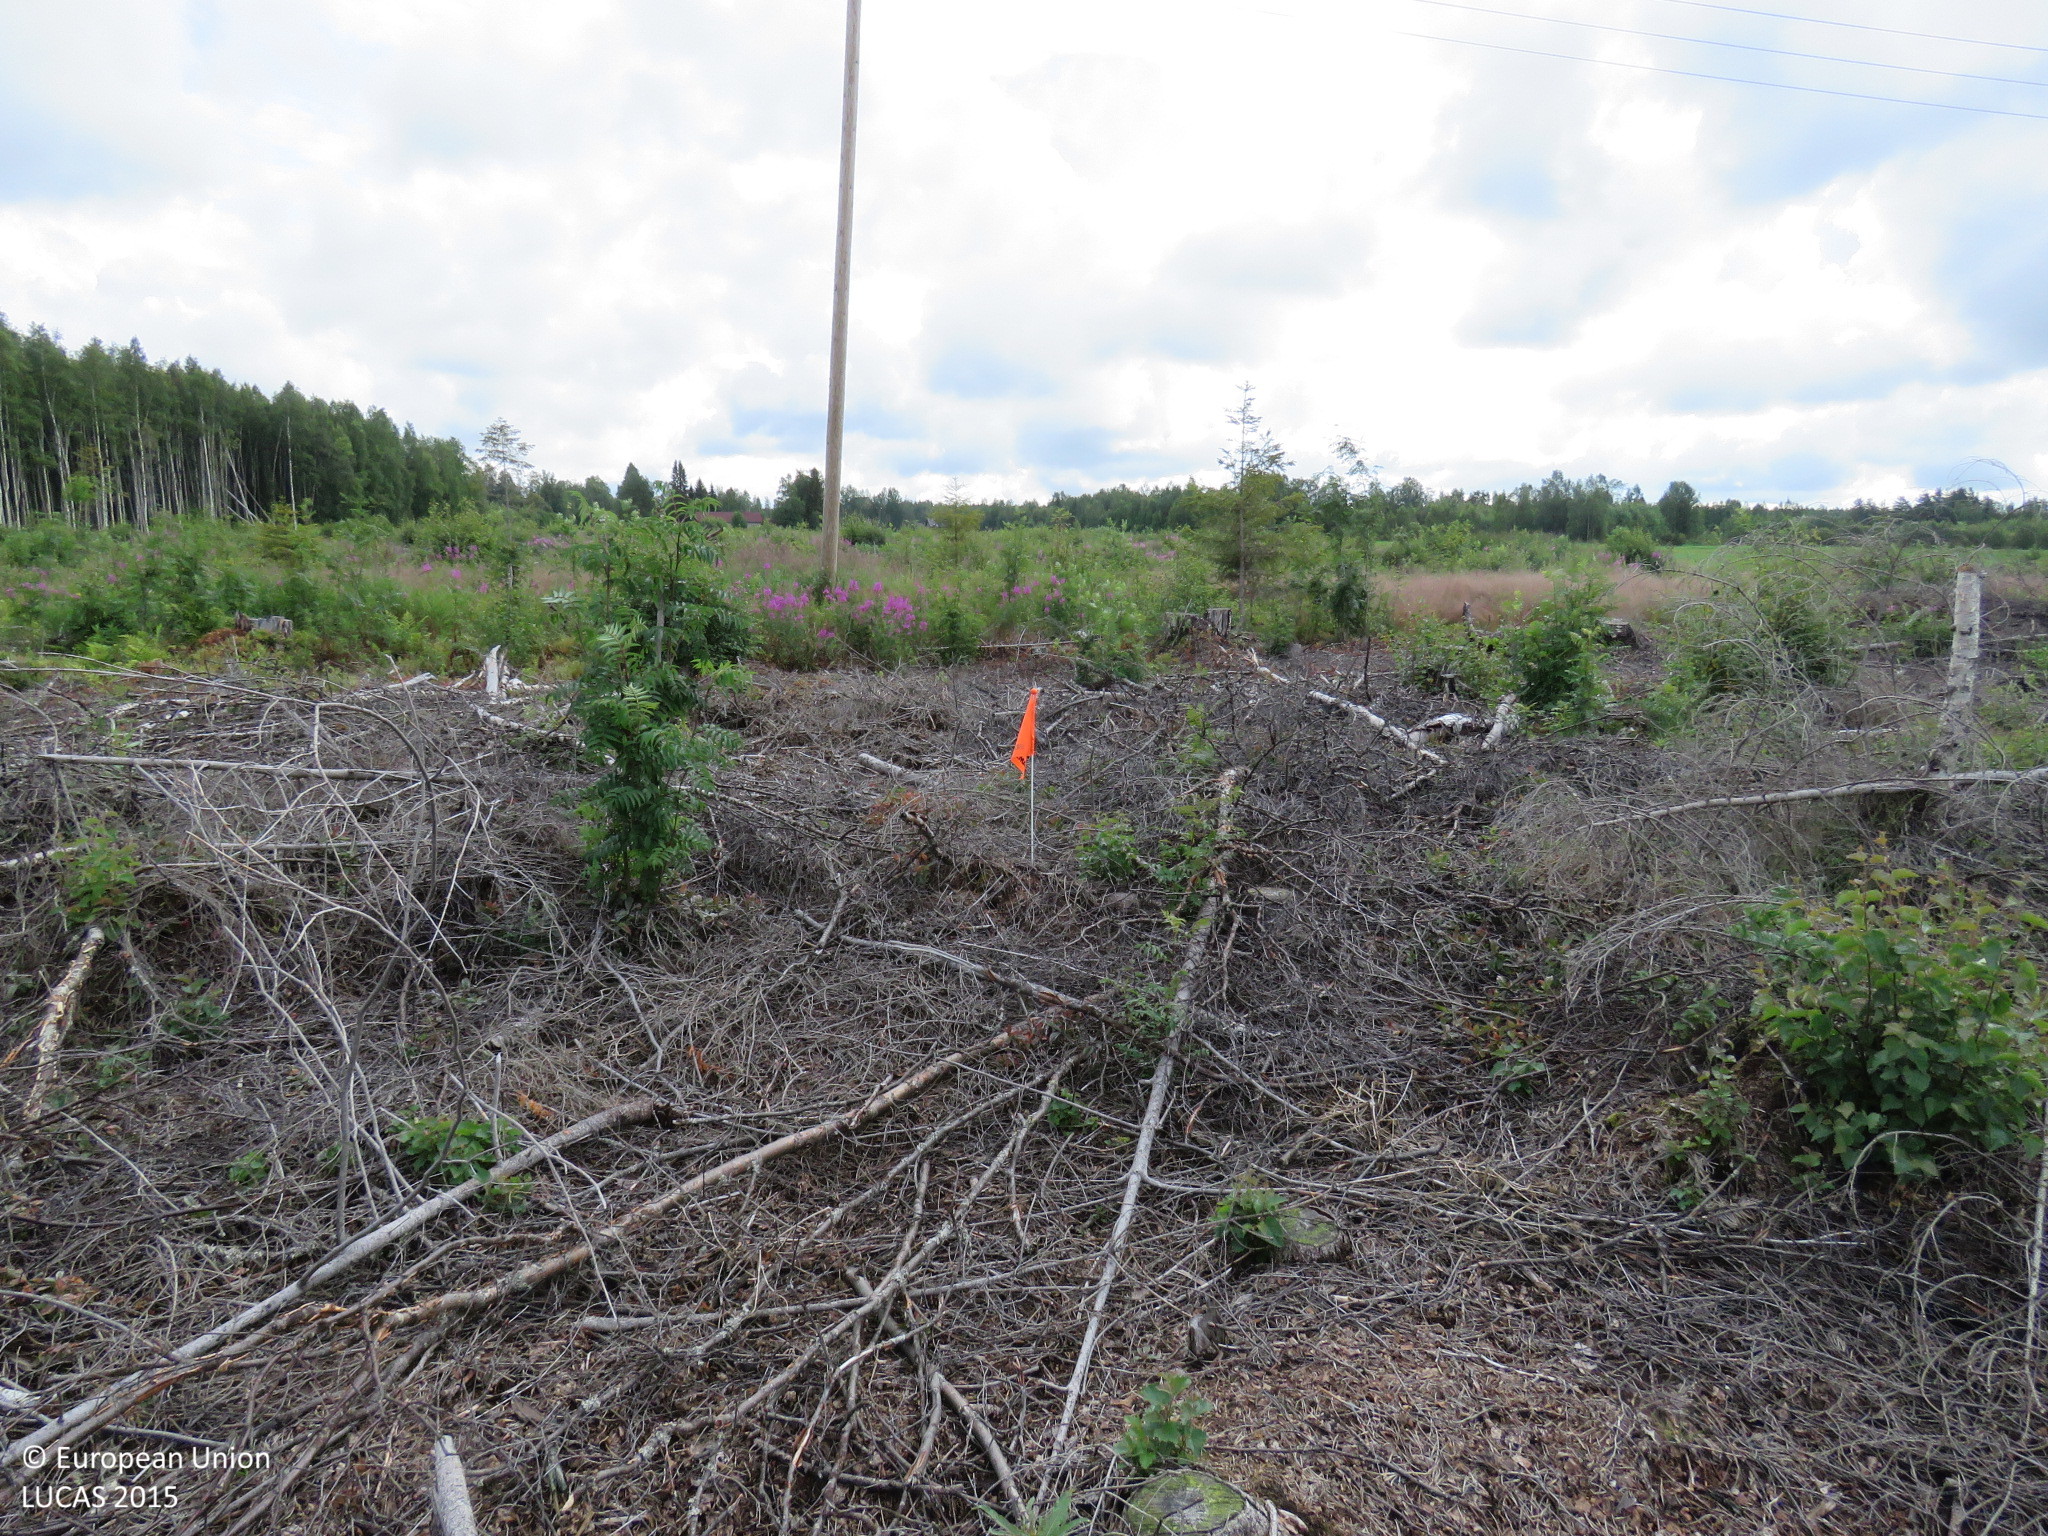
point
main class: Woodland
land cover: Broadleaved woodland
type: boreal forest
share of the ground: 10 - 25 %
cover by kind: broadleaved forest trees 15 %, herbaceous plants 10 %, unconsolidated bare surface 10 %, coniferous forest trees 5 %, shrubs 5 %
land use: Forestry
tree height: < 5 m
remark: Clear cut
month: July
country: FI
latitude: 64.8812
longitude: 25.5625
